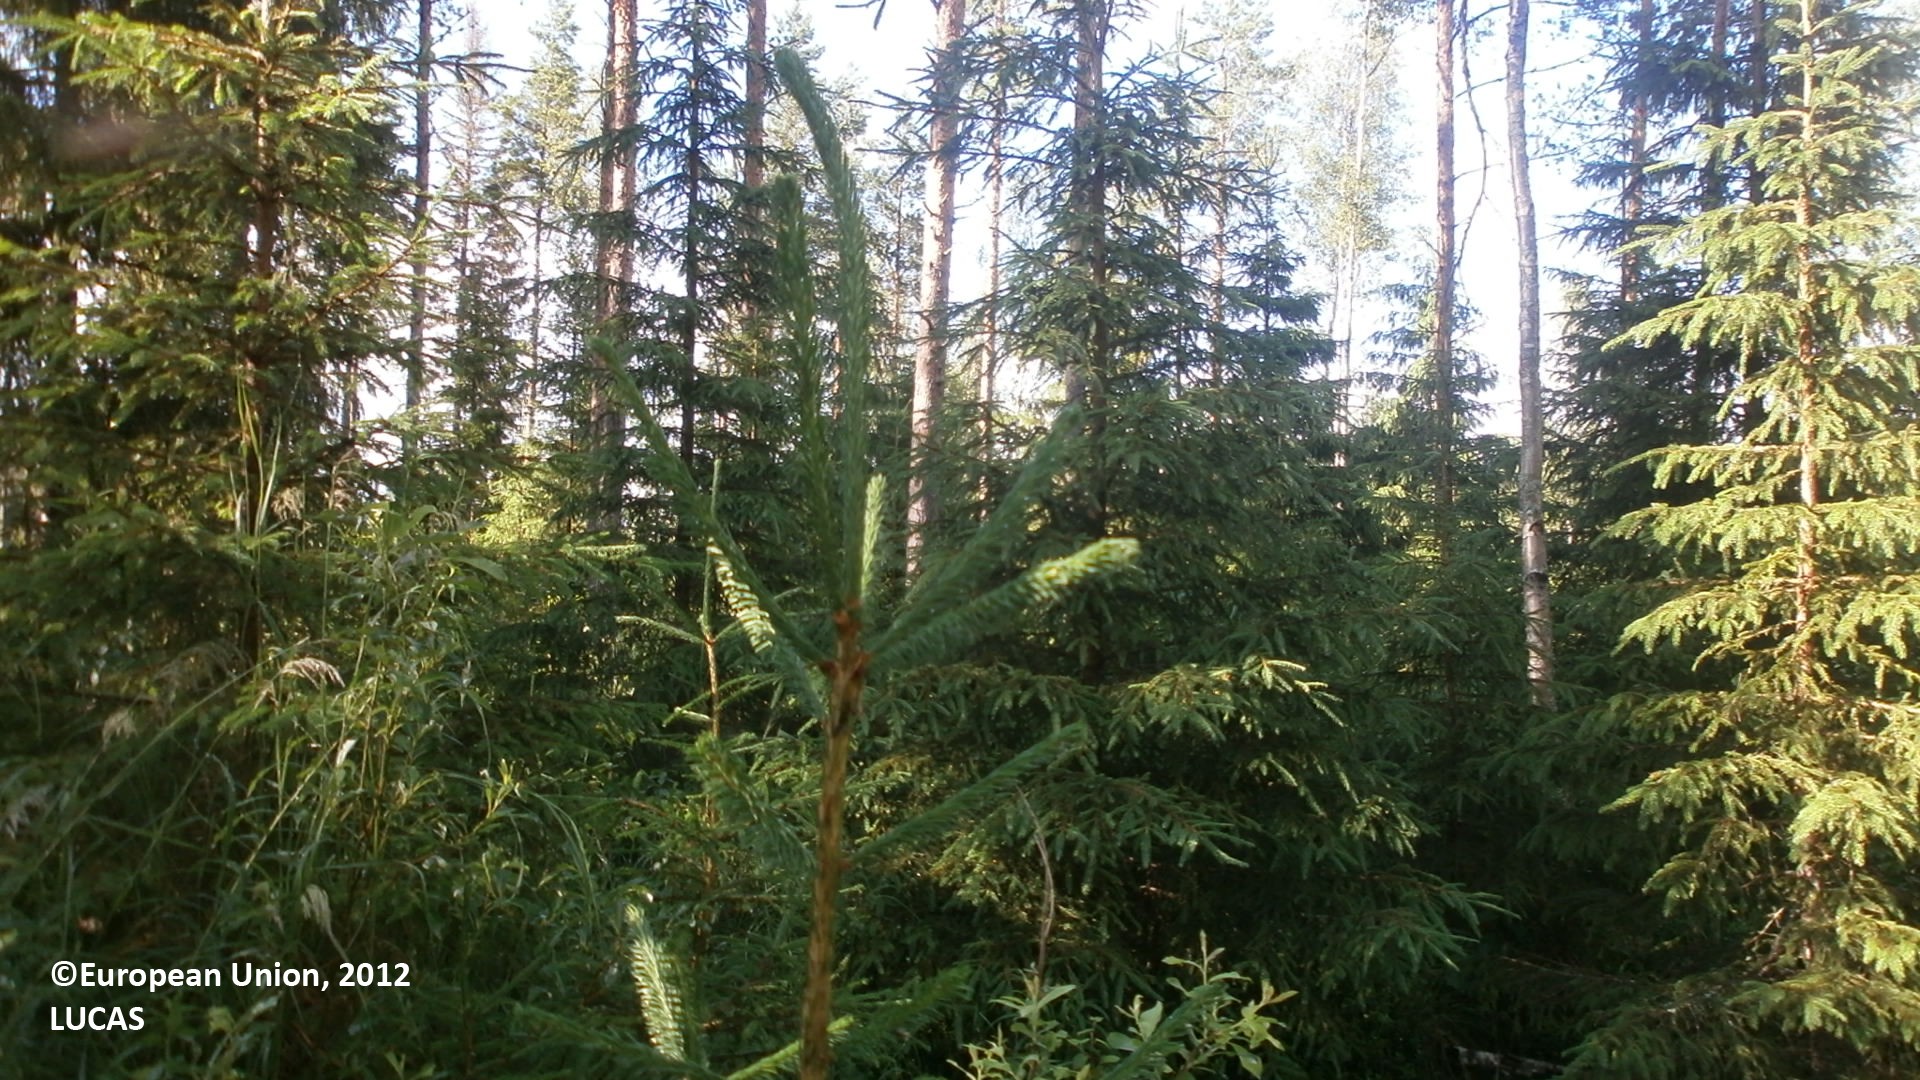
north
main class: Woodland
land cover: Pine dominated mixed woodland
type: boreal forest
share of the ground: 50 - 75 %
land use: Forestry
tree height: > 5 m
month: July
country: FI
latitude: 64.4425
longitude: 24.3391
